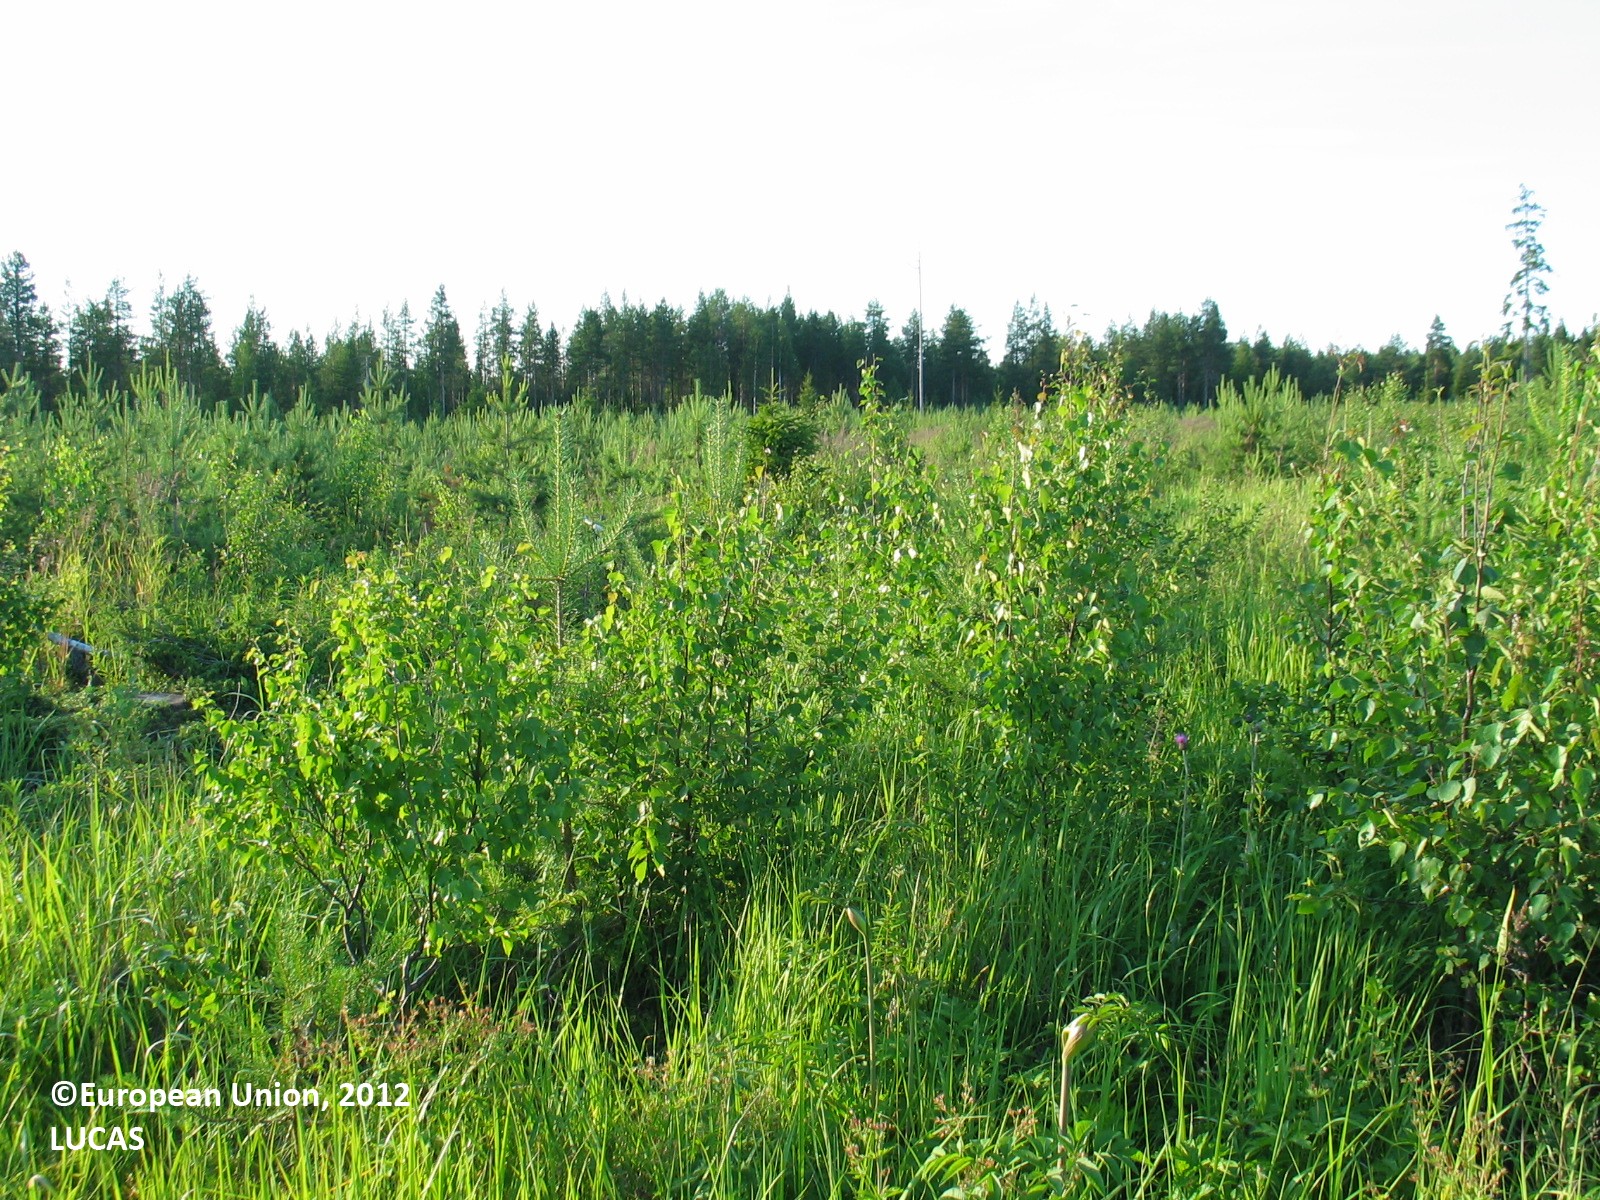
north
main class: Woodland
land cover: Other mixed woodland
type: boreal forest
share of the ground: 10 - 25 %
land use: Forestry
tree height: < 5 m
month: July
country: FI
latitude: 65.8647
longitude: 24.9430
